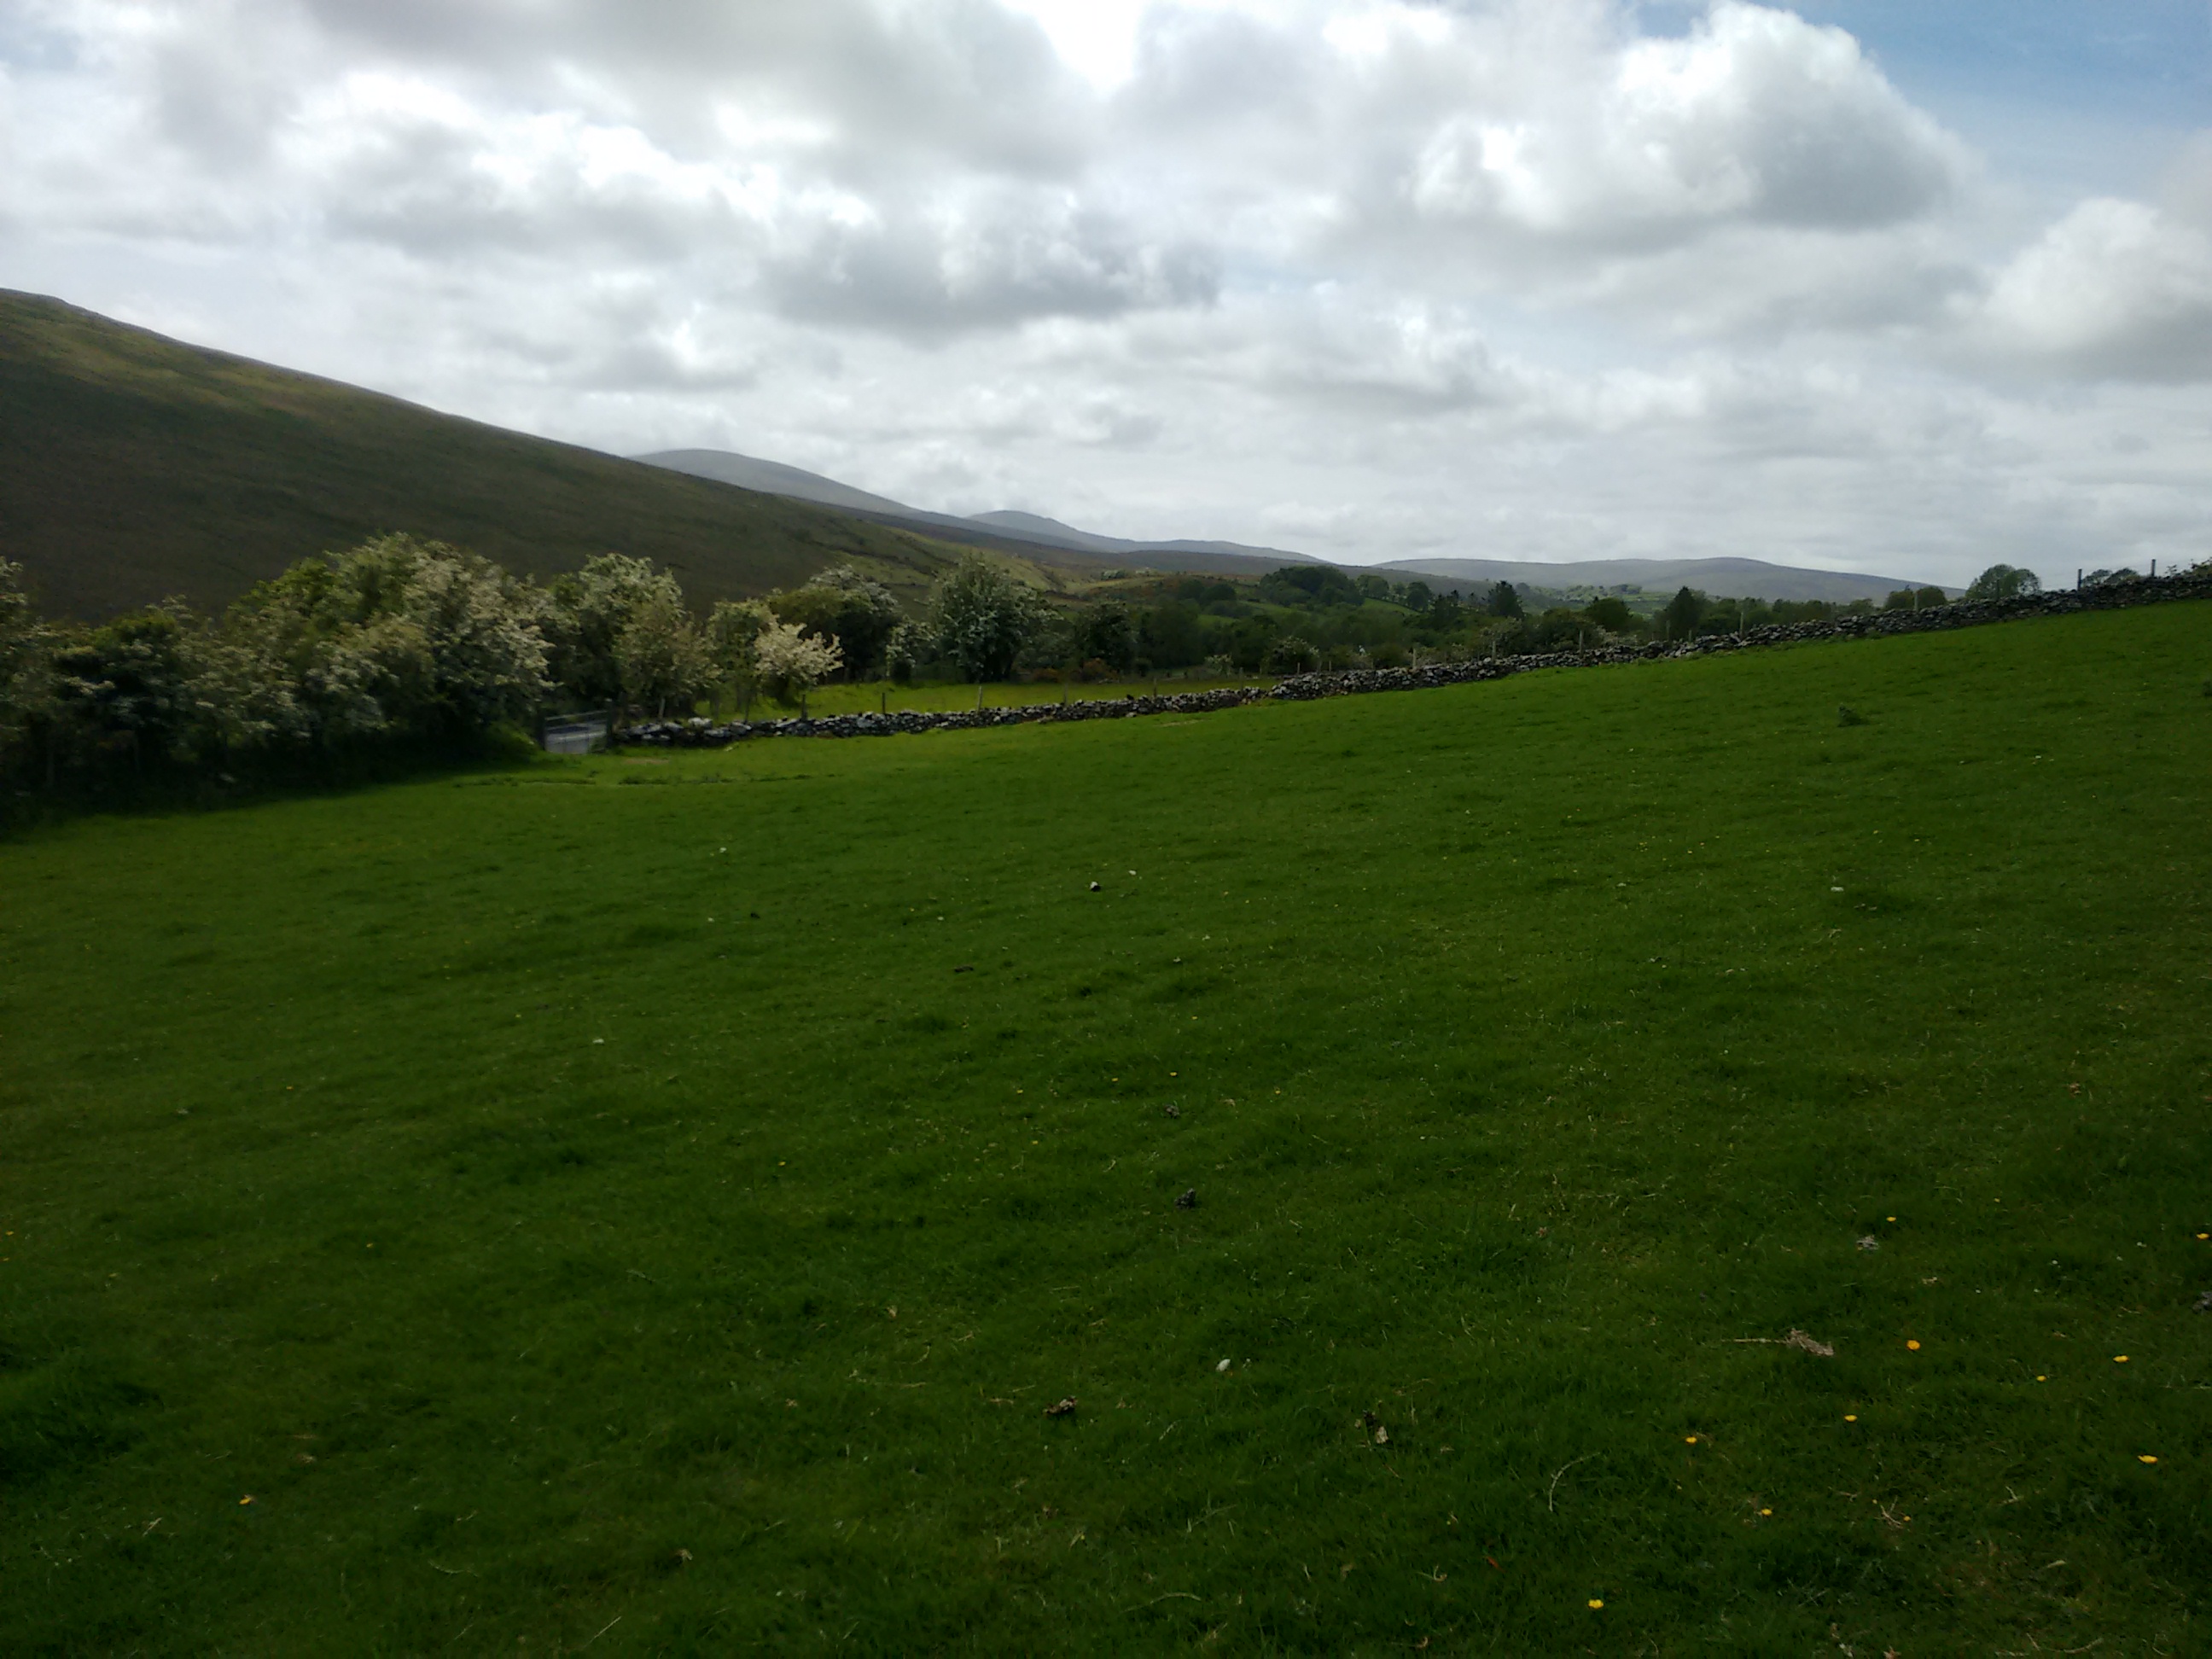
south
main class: Grassland
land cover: Grassland without tree/shrub cover
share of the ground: > 75 %
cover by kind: herbaceous plants 100 %
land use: Agriculture (excluding fallow land and kitchen gardens)
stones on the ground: 25 - 50 %
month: June
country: GB
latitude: 54.8724
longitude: -7.0158
